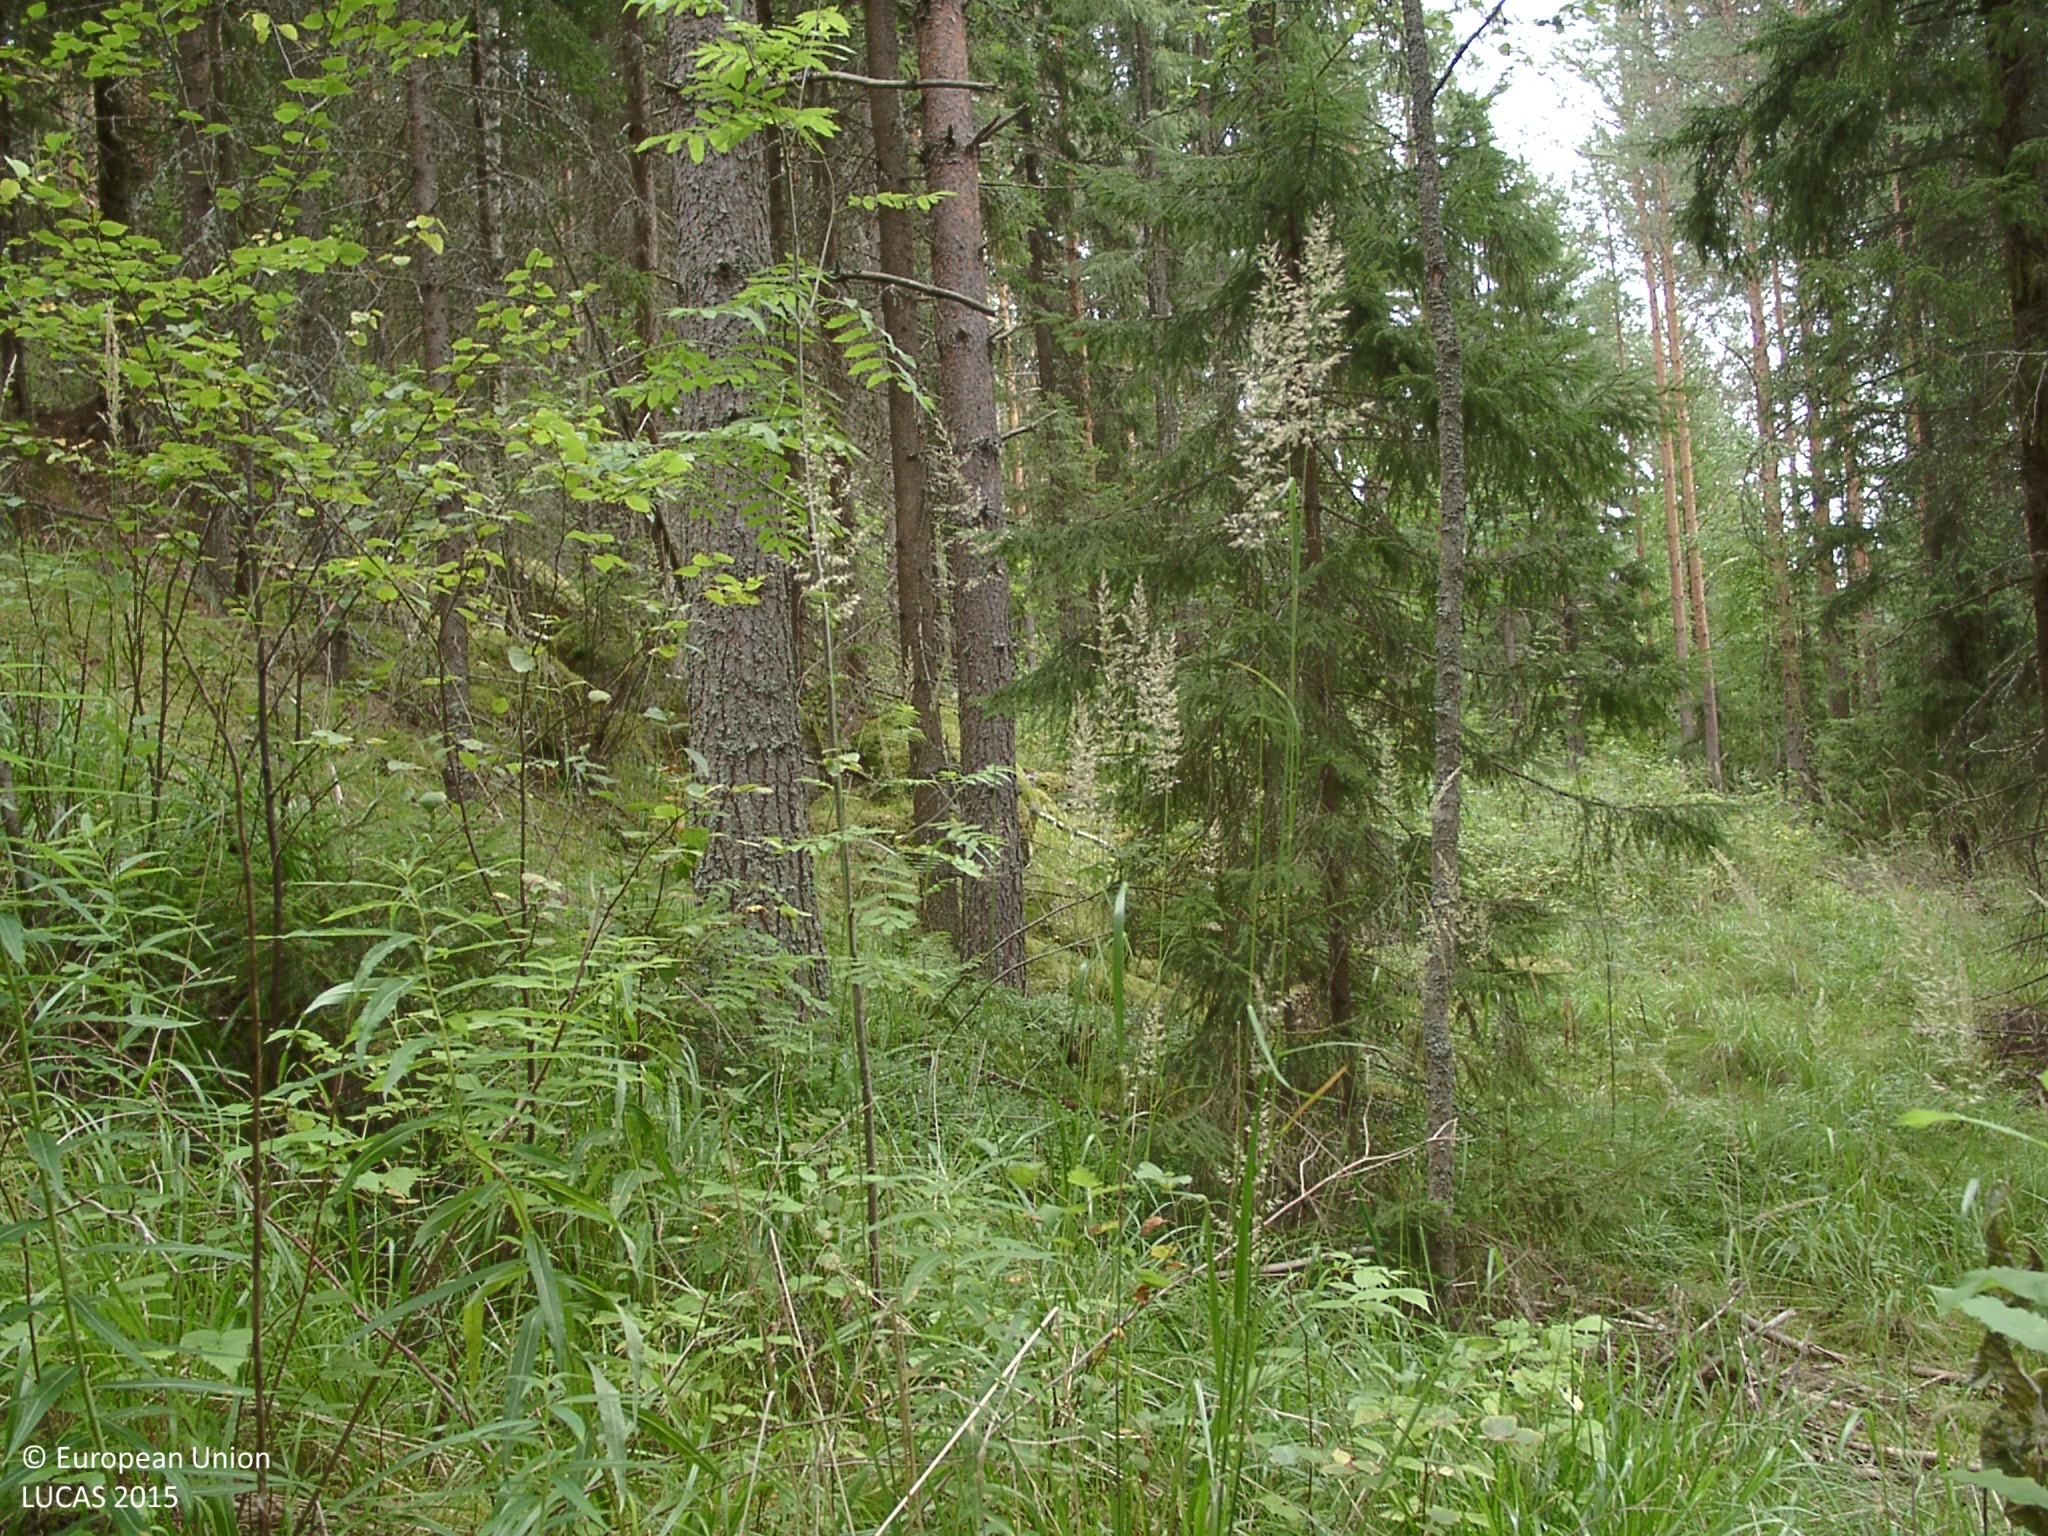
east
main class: Woodland
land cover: Other coniferous woodland
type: boreal forest
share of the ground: > 75 %
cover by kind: coniferous forest trees 60 %, broadleaved forest trees 15 %, lichens and mosses 10 %, unconsolidated bare surface 10 %, shrubs 5 %
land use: Forestry
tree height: > 5 m
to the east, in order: Grass margins; Other coniferous woodland; Shruby margins; Other coniferous woodland; Other mixed woodland; Other coniferous woodland; Shruby margins; Groves; Shruby margins; Other coniferous woodland; Grass margins; Spruce dominated coniferous woodland
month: August
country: FI
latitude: 61.8175
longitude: 25.3561
